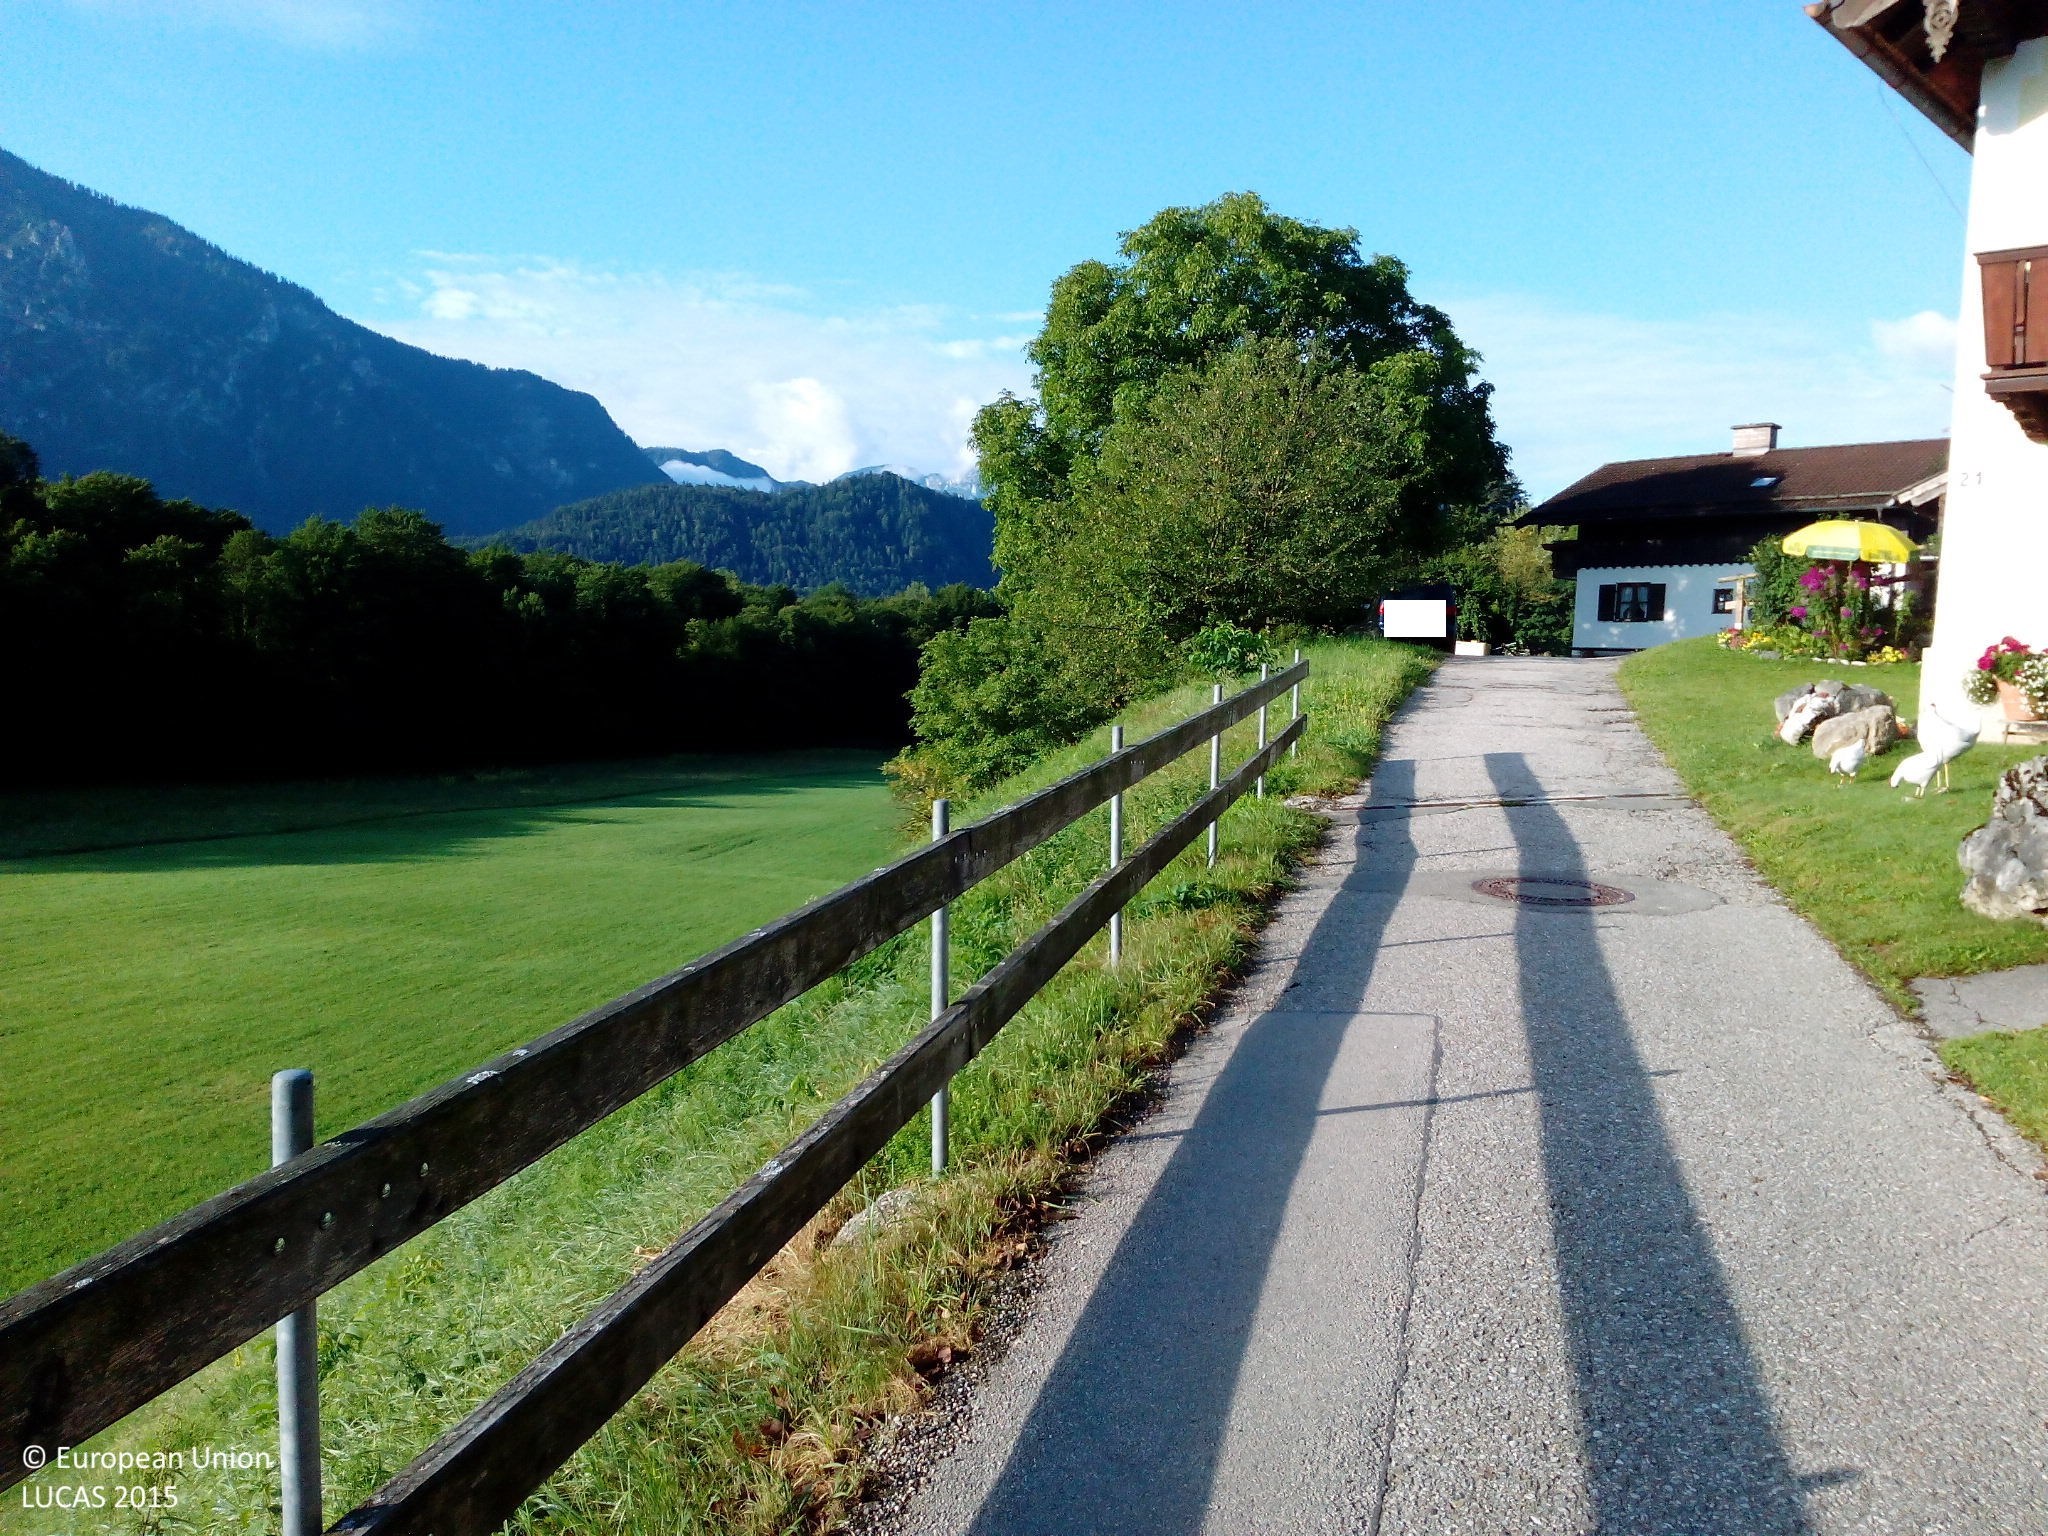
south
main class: Woodland
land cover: Broadleaved woodland
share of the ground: > 75 %
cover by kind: broadleaved forest trees 75 %, herbaceous plants 25 %
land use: Residential
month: August
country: DE
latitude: 47.7361
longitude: 12.8655
